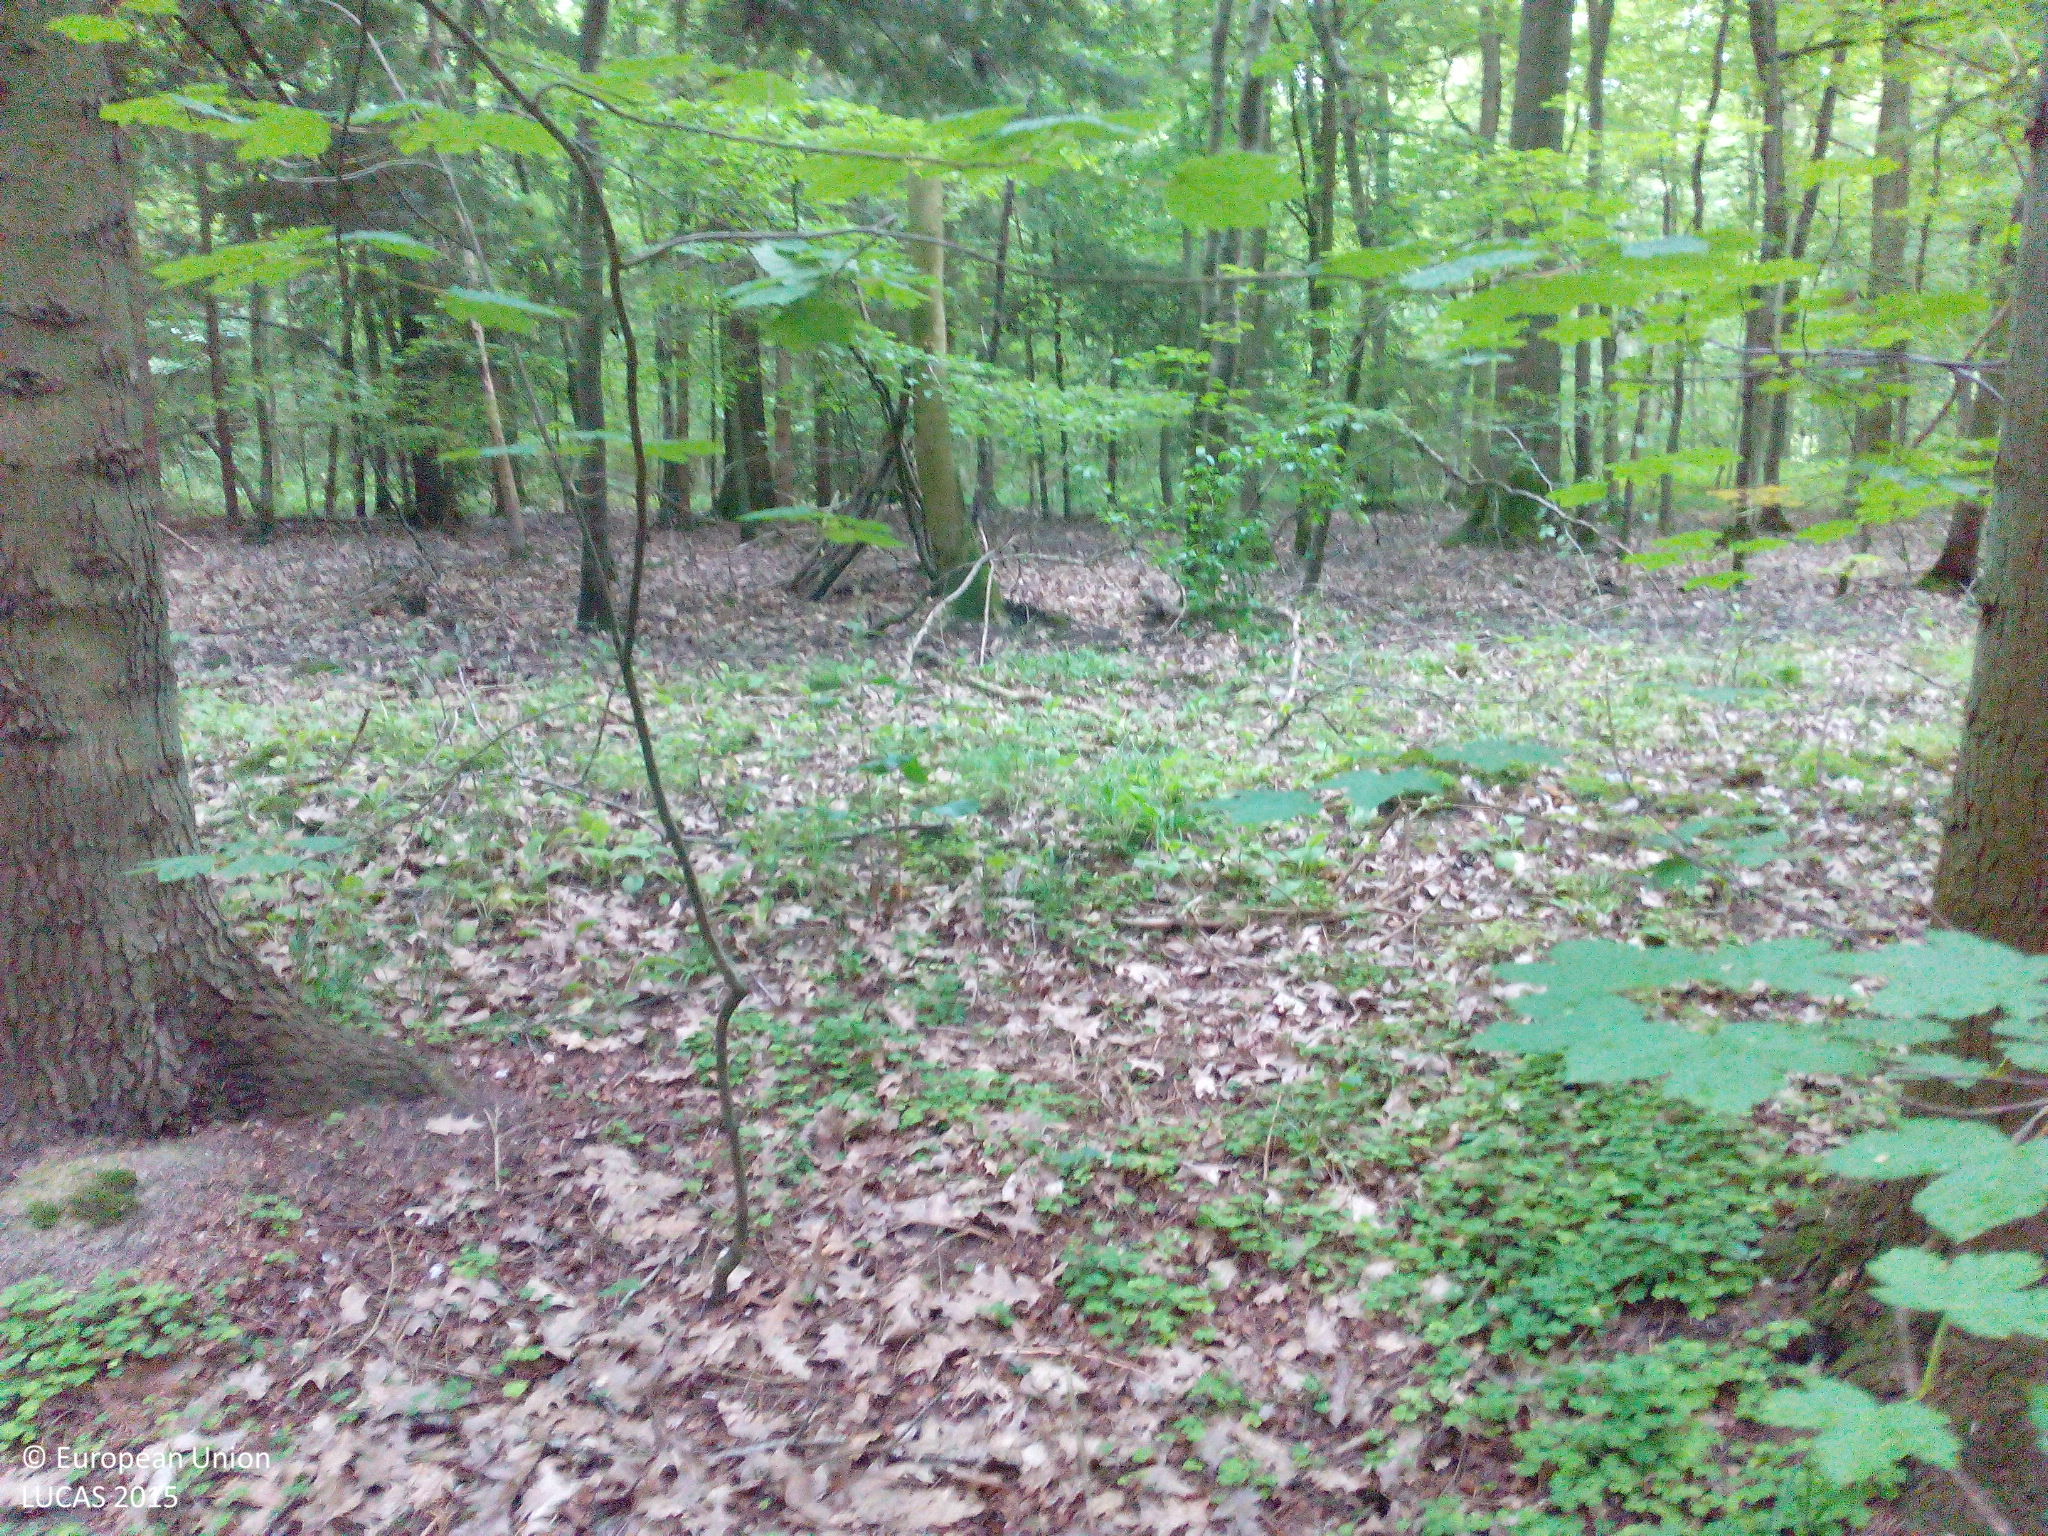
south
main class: Woodland
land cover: Other coniferous woodland
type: acidophilous oak and oak-birch forest
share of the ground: > 75 %
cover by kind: coniferous forest trees 70 %, broadleaved forest trees 20 %, herbaceous plants 5 %, unconsolidated bare surface 5 %
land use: Forestry
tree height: > 5 m
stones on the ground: 10 - 25 %
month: August
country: DK
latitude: 55.5451
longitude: 11.8527
